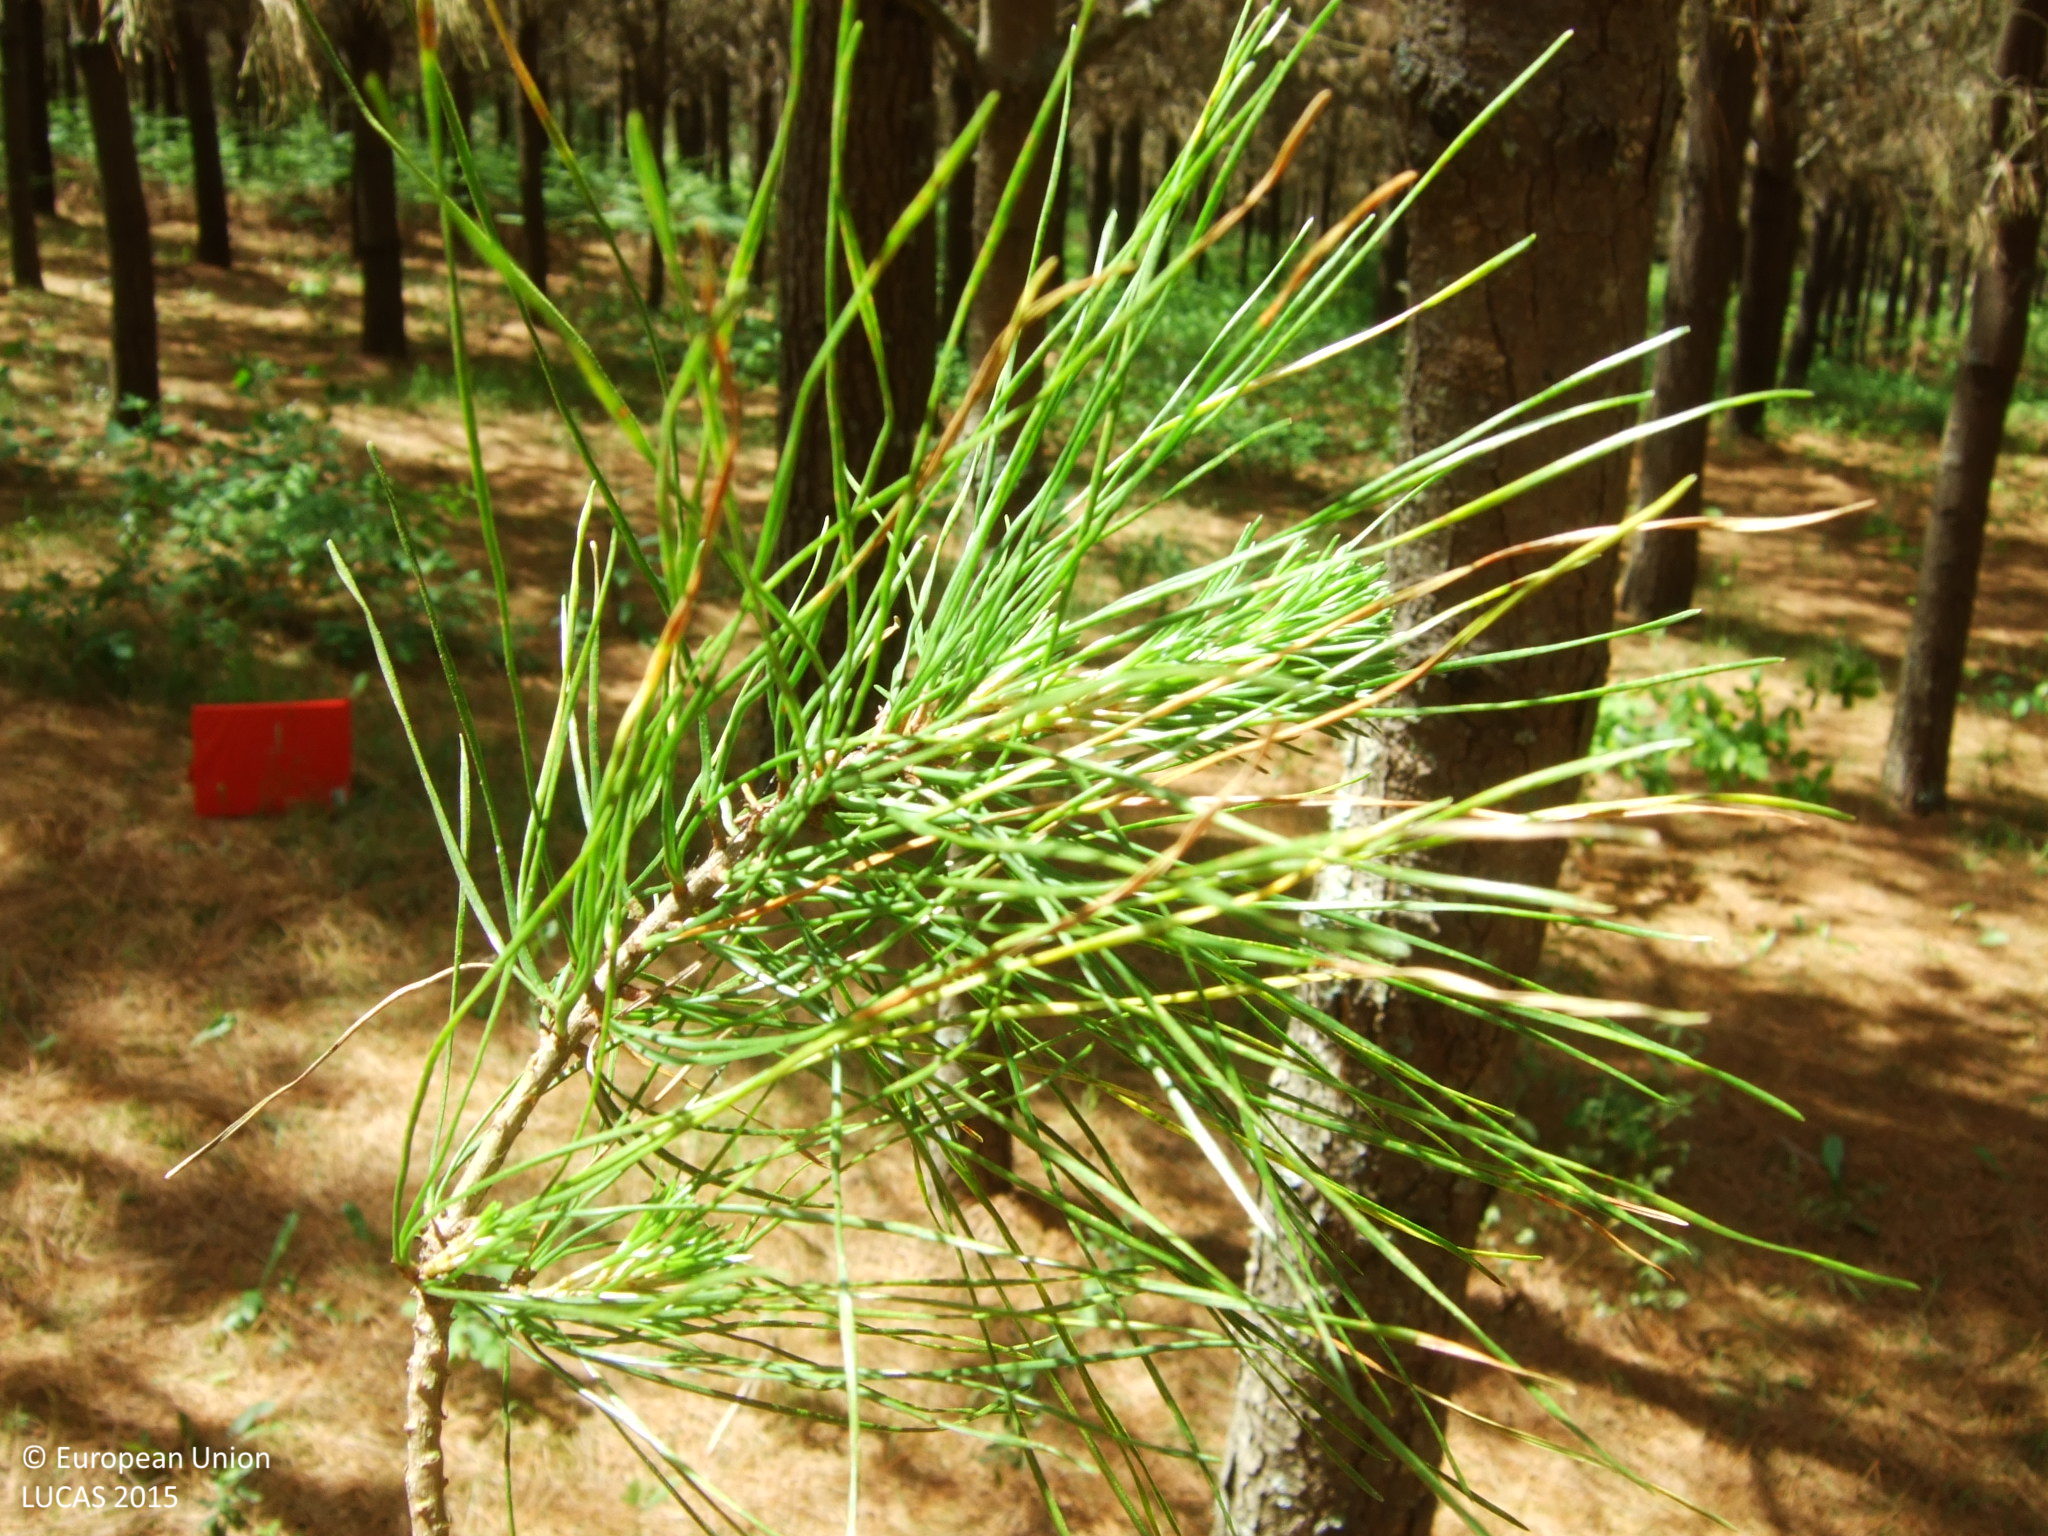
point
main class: Woodland
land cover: Pine dominated coniferous woodland
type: exotic forest
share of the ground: 50 - 75 %
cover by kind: coniferous forest trees 65 %, unconsolidated bare surface 25 %, shrubs 10 %
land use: Forestry
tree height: > 5 m
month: May
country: ES
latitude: 42.8723
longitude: -7.3674
